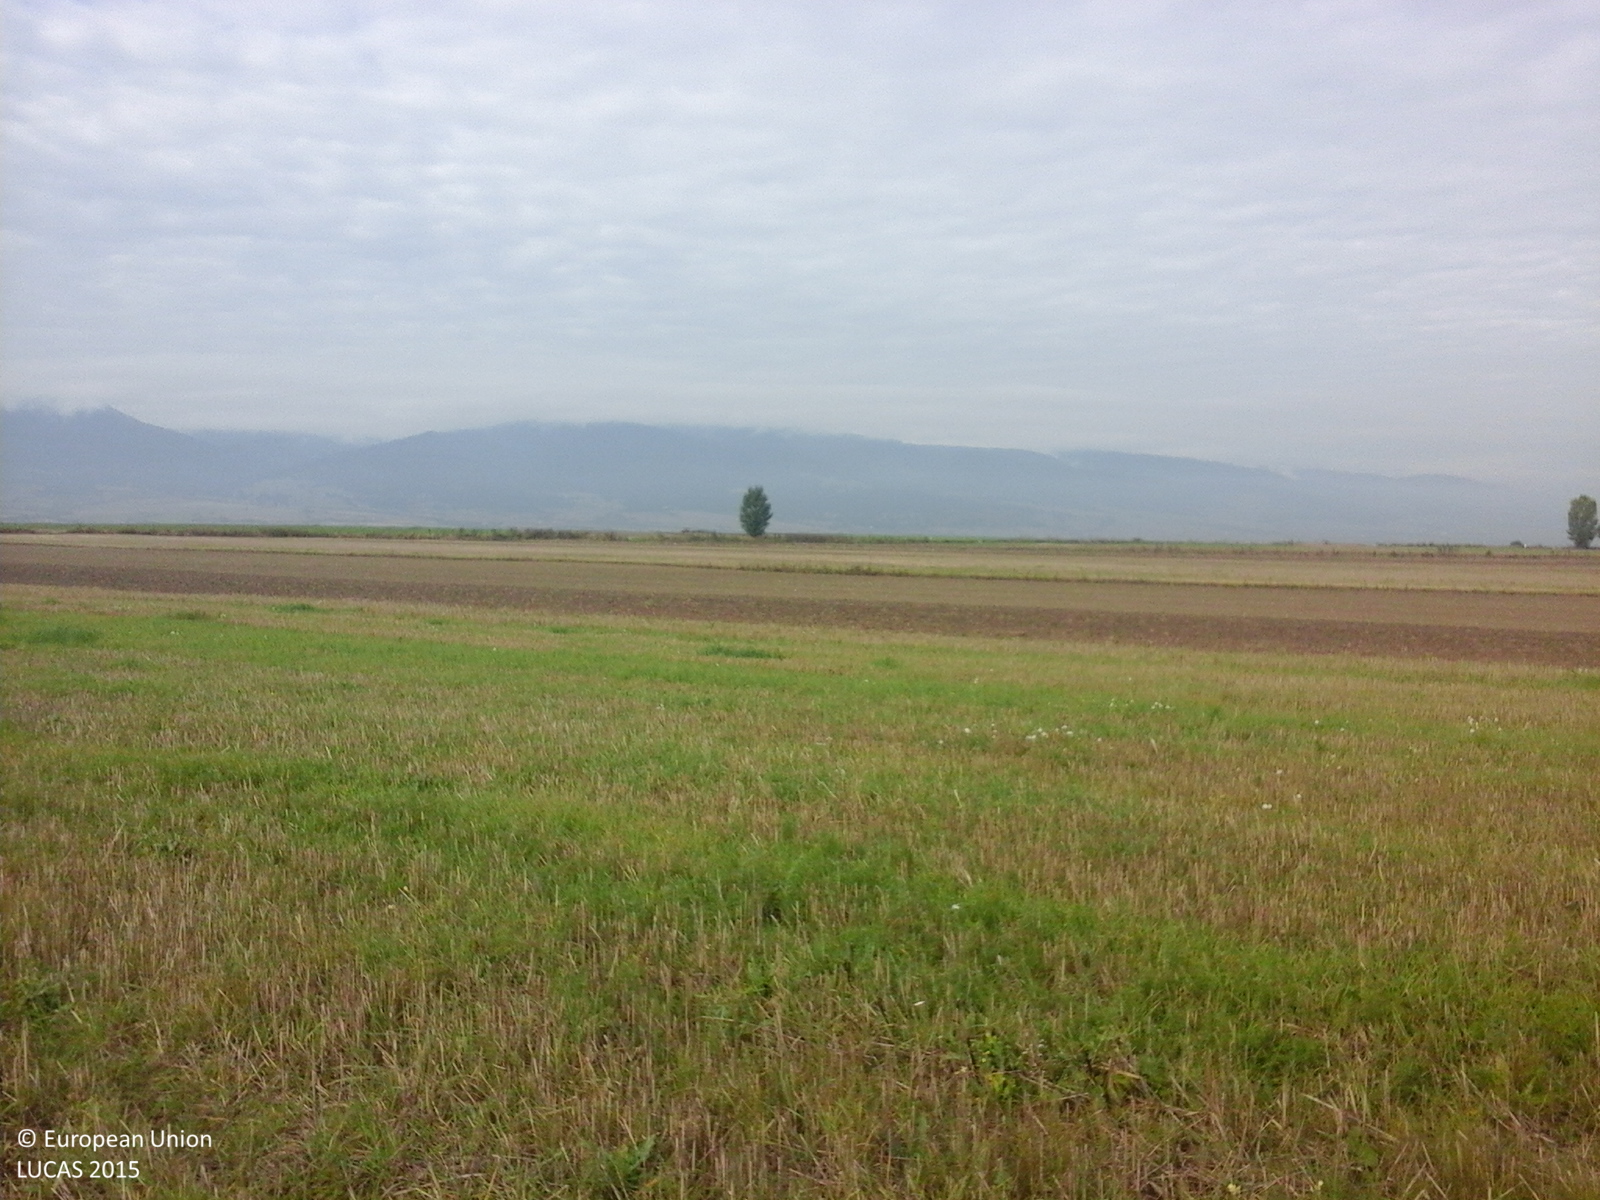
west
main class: Cropland
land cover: Common wheat
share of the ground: > 75 %
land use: Agriculture (excluding fallow land and kitchen gardens)
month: October
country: RO
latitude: 46.2135
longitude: 25.9179
